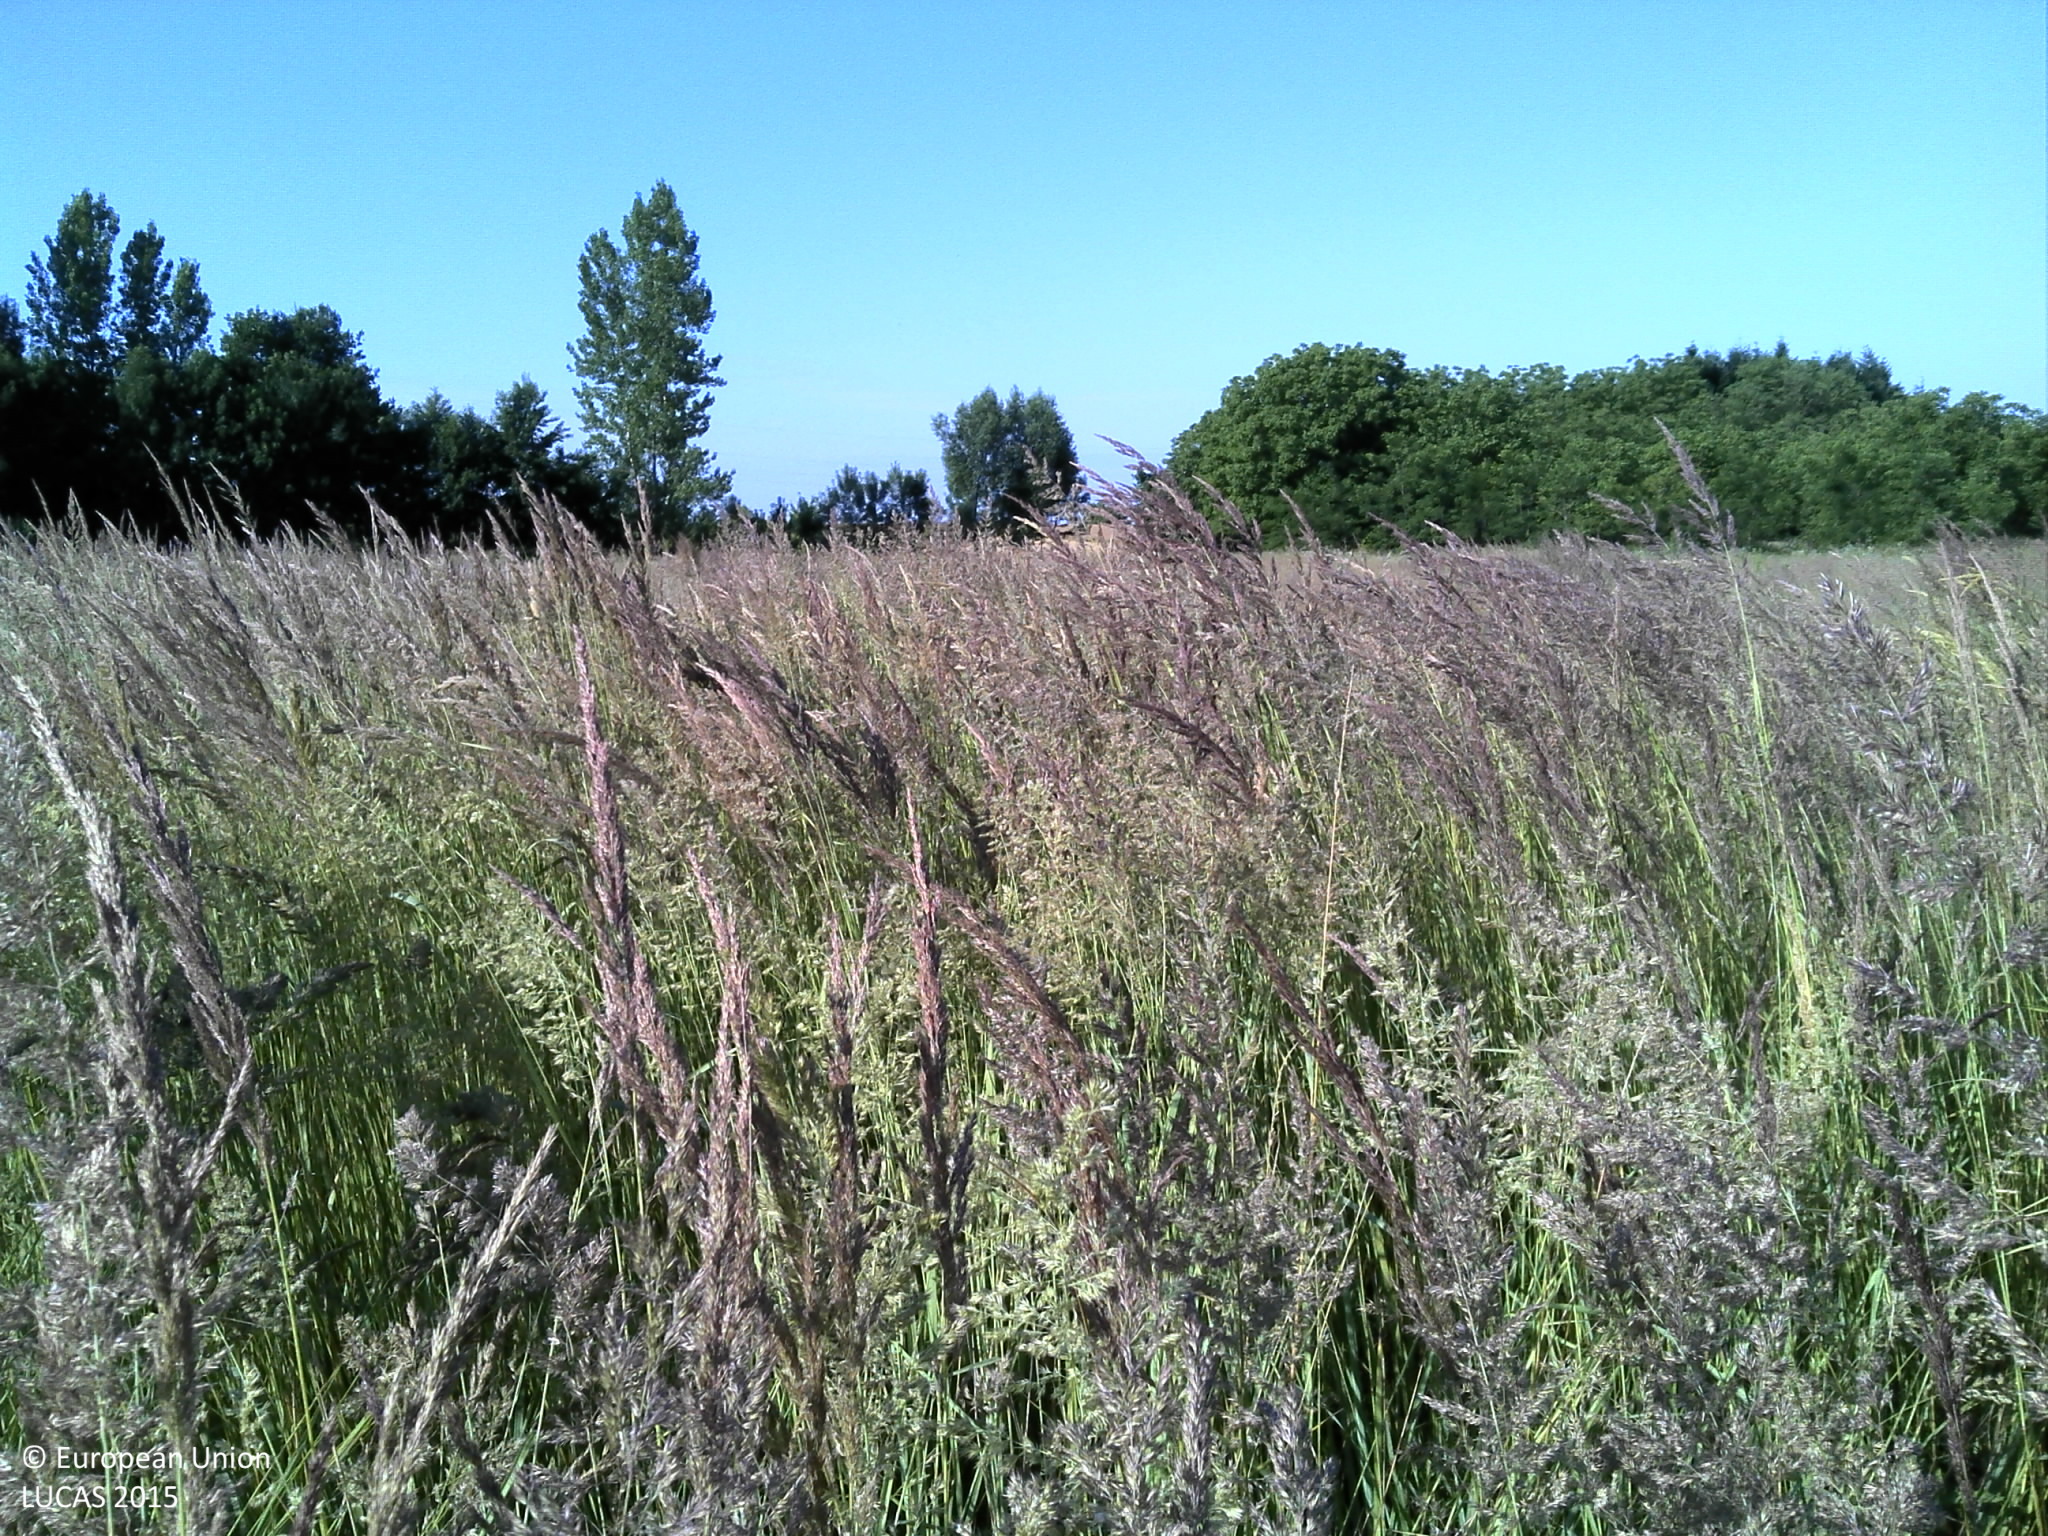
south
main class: Grassland
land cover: Grassland without tree/shrub cover
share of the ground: > 75 %
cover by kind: herbaceous plants 100 %
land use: Semi-natural and natural areas not in use
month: June
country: HR
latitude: 45.6174
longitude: 18.4579
